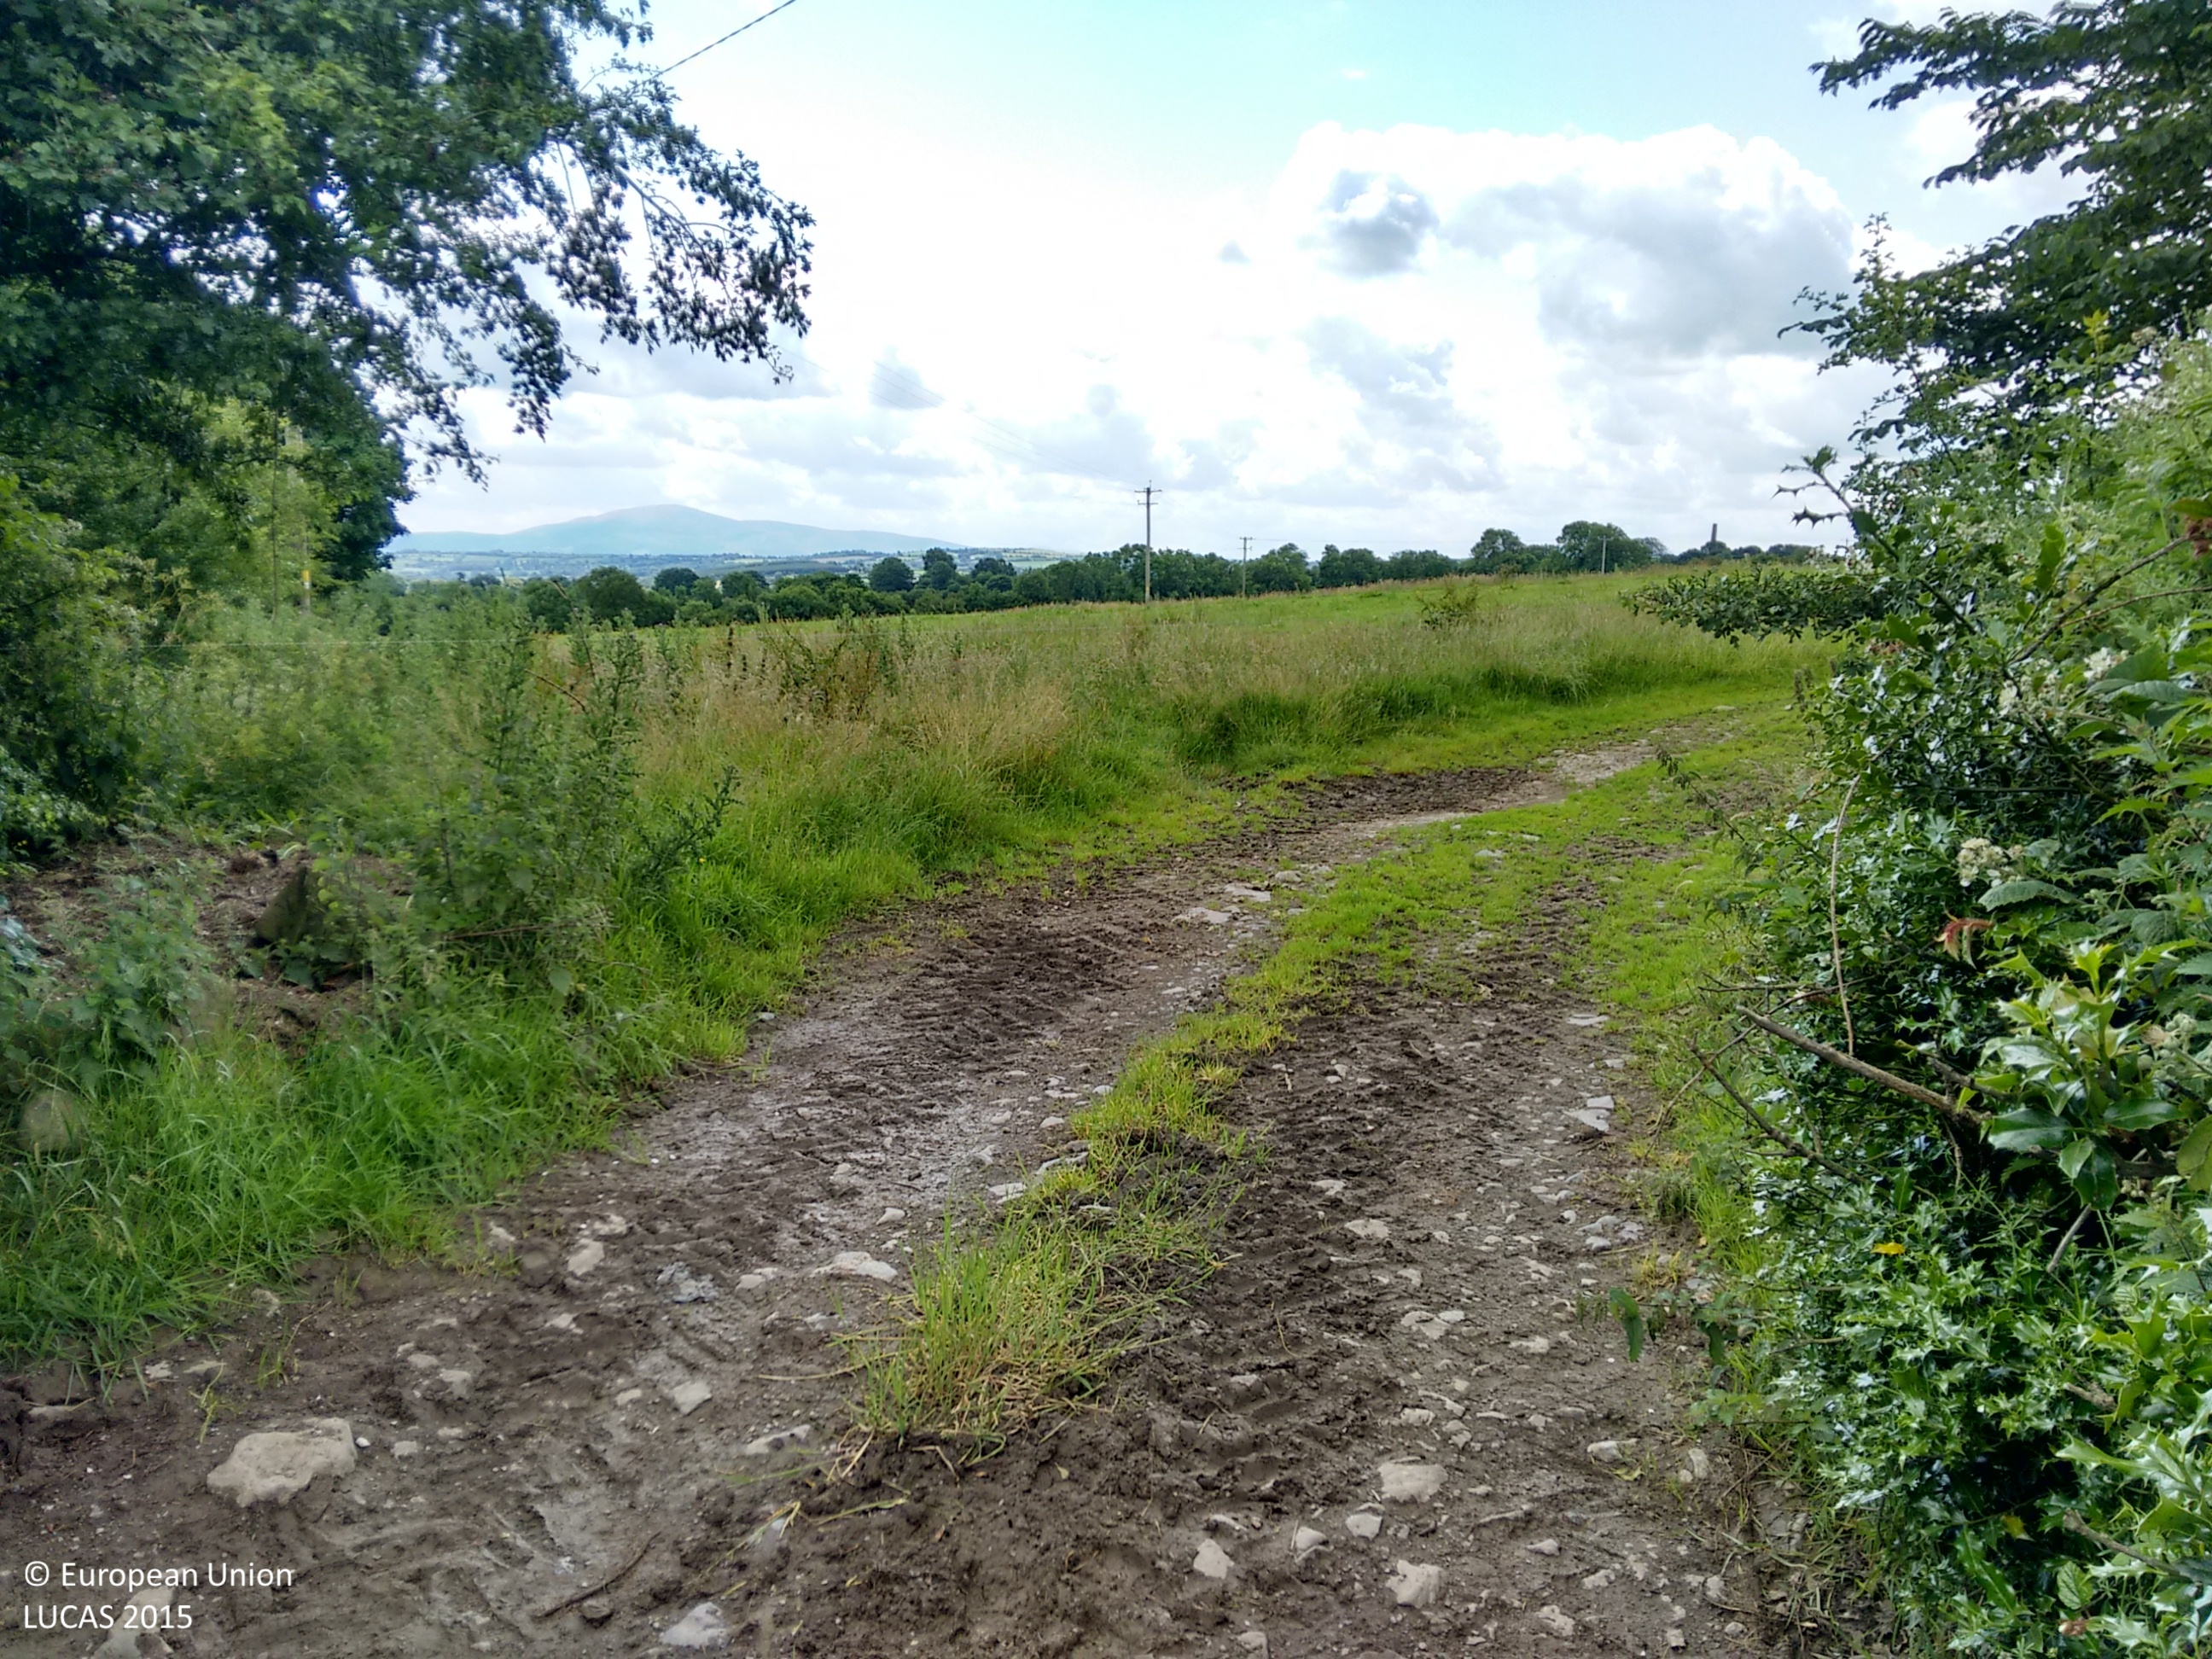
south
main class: Grassland
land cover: Grassland without tree/shrub cover
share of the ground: > 75 %
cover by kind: herbaceous plants 100 %
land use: Agriculture (excluding fallow land and kitchen gardens)
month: July
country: IE
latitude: 52.5999
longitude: -7.5683
